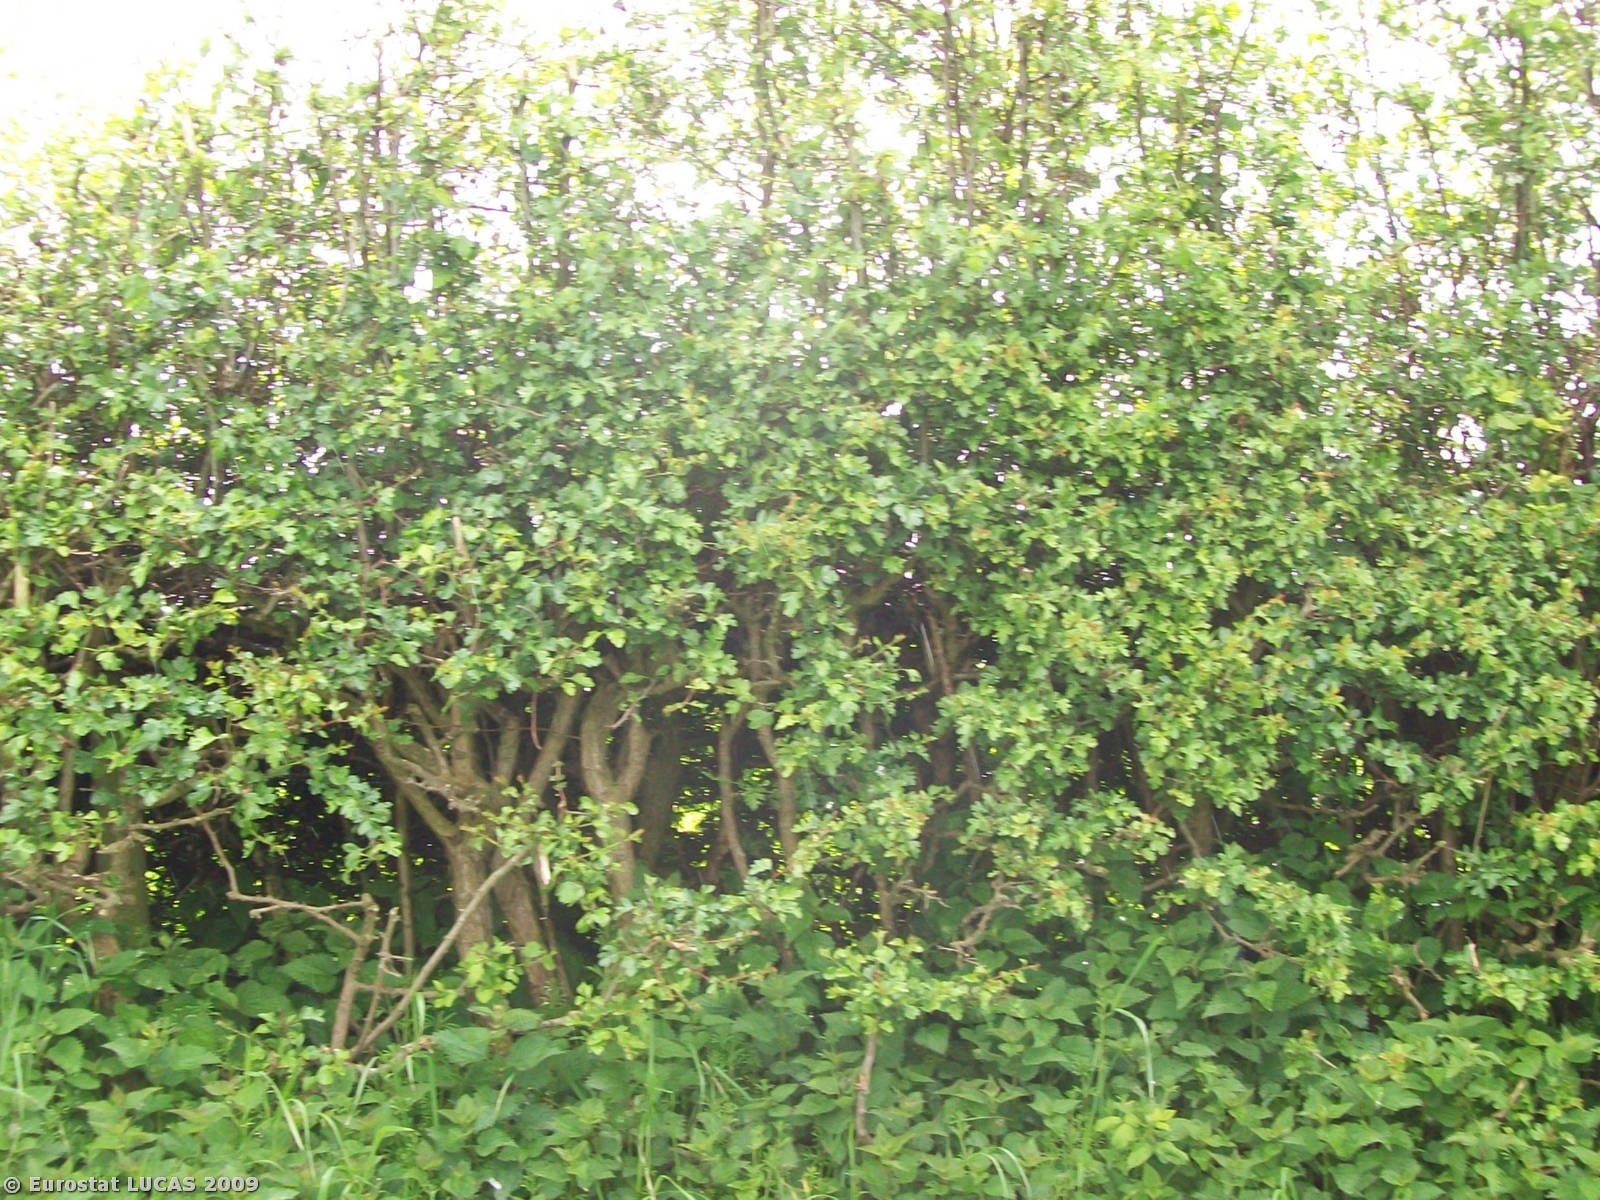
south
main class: Grassland
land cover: Grassland without tree/shrub cover
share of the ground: > 75 %
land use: Agriculture (excluding fallow land and kitchen gardens)
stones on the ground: < 10 %
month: May
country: GB
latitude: 53.8269
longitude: -3.0027
